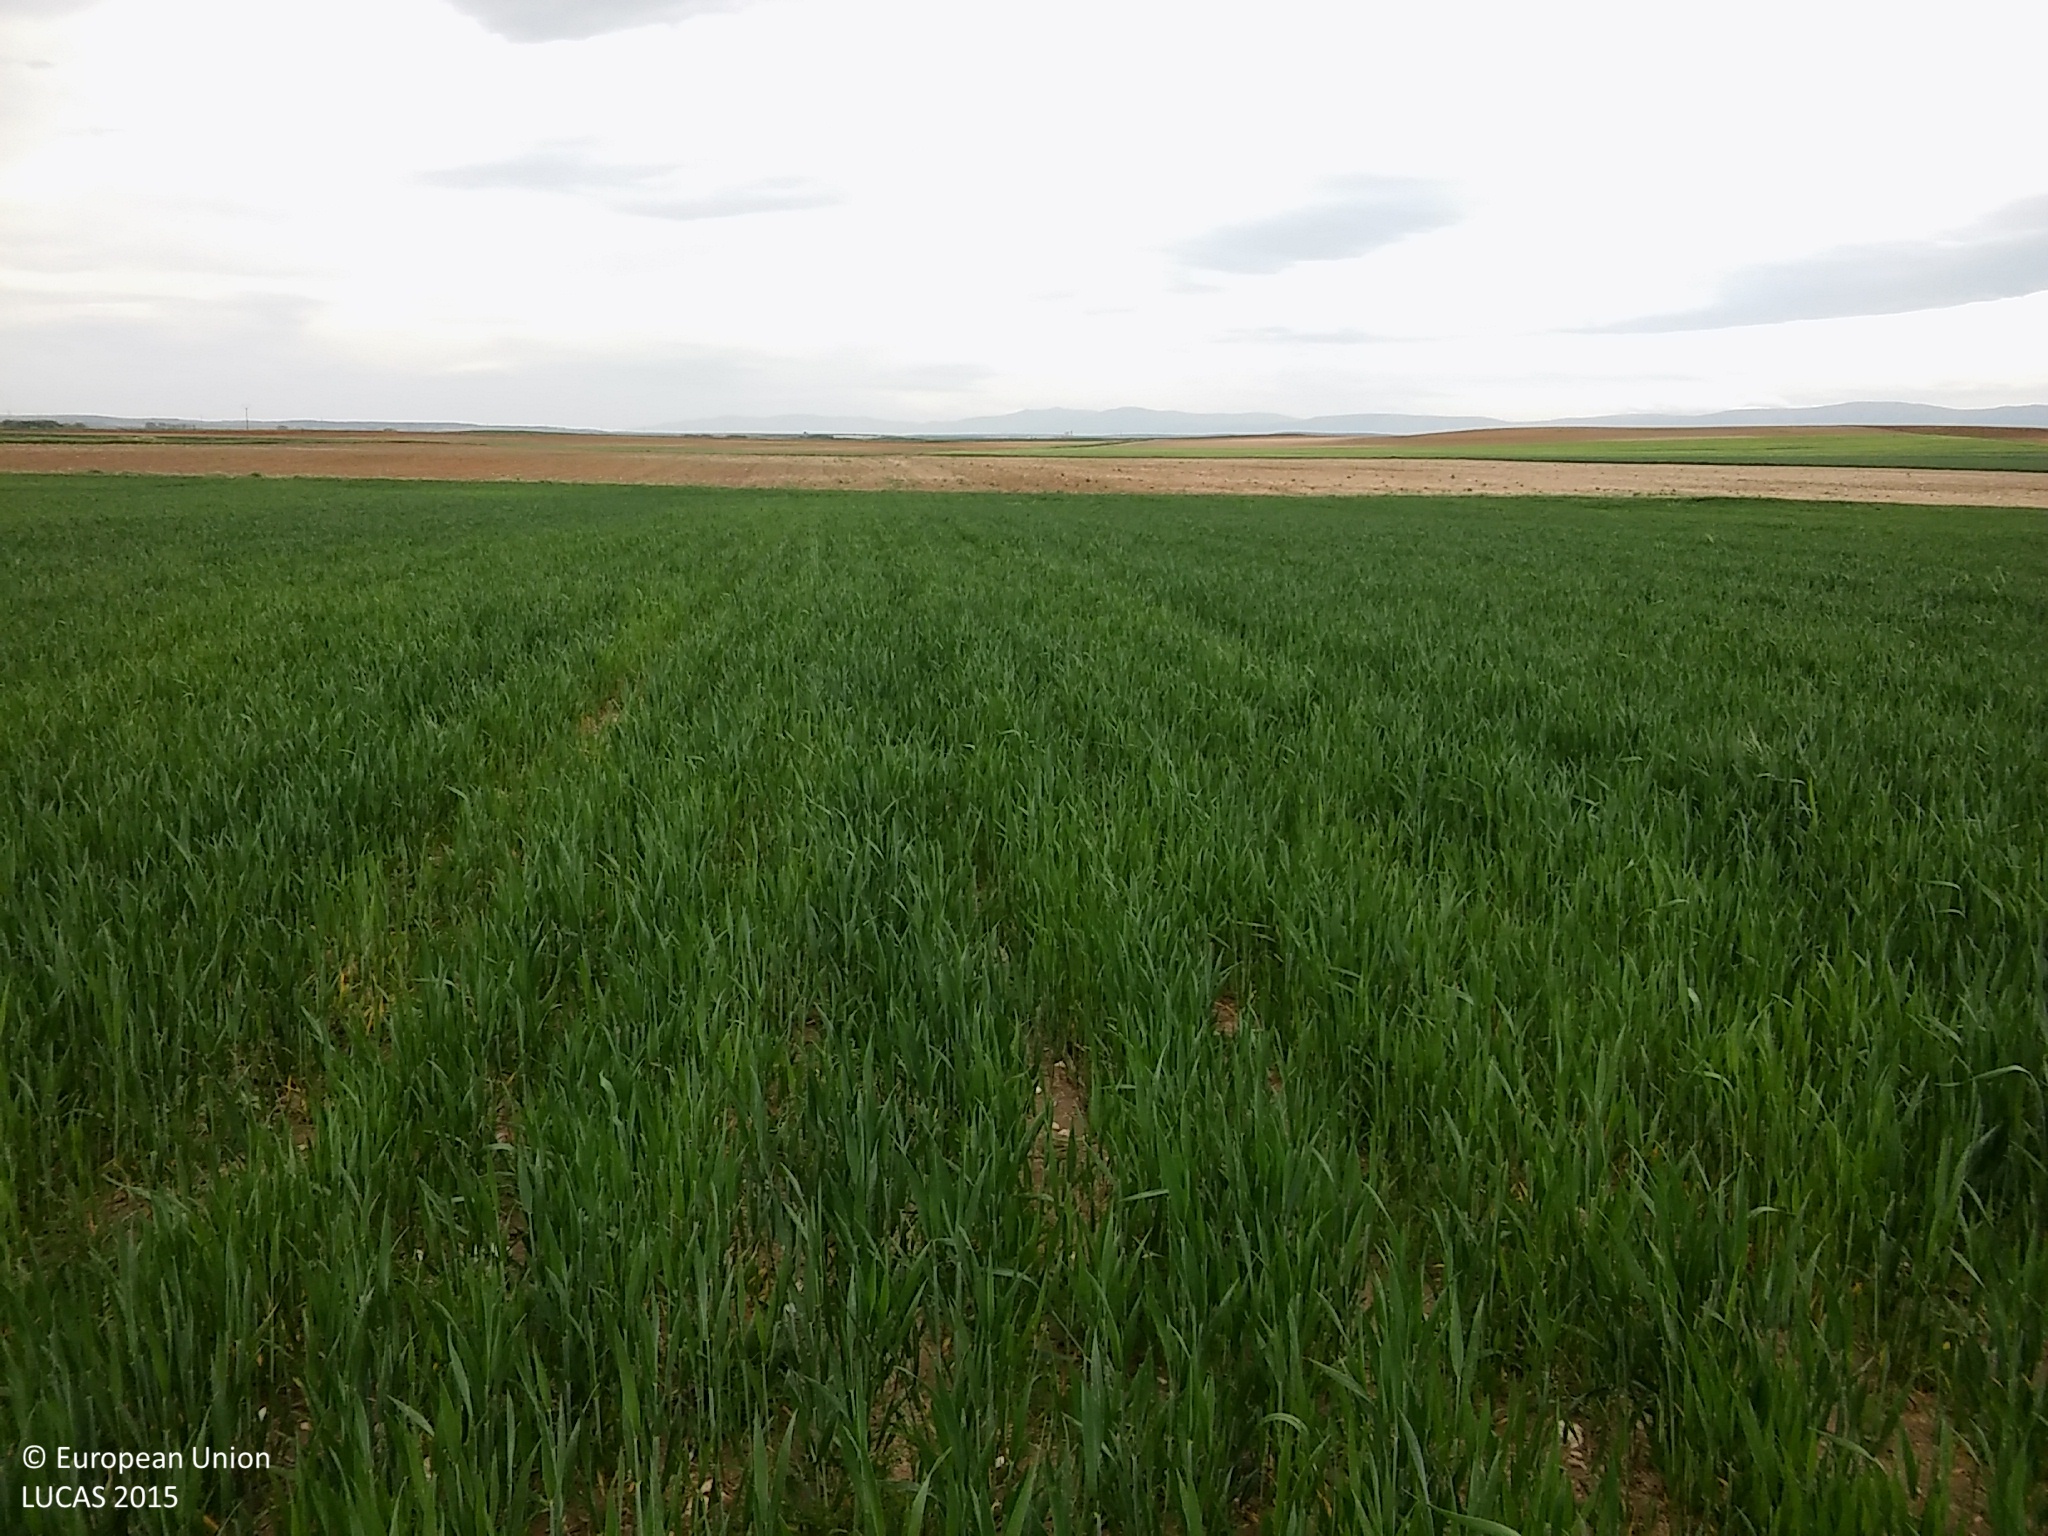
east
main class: Cropland
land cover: Common wheat
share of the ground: 50 - 75 %
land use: Agriculture (excluding fallow land and kitchen gardens)
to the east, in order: Common wheat; Grass margins; Sunflower
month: May
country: ES
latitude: 41.1559
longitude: -4.0540
